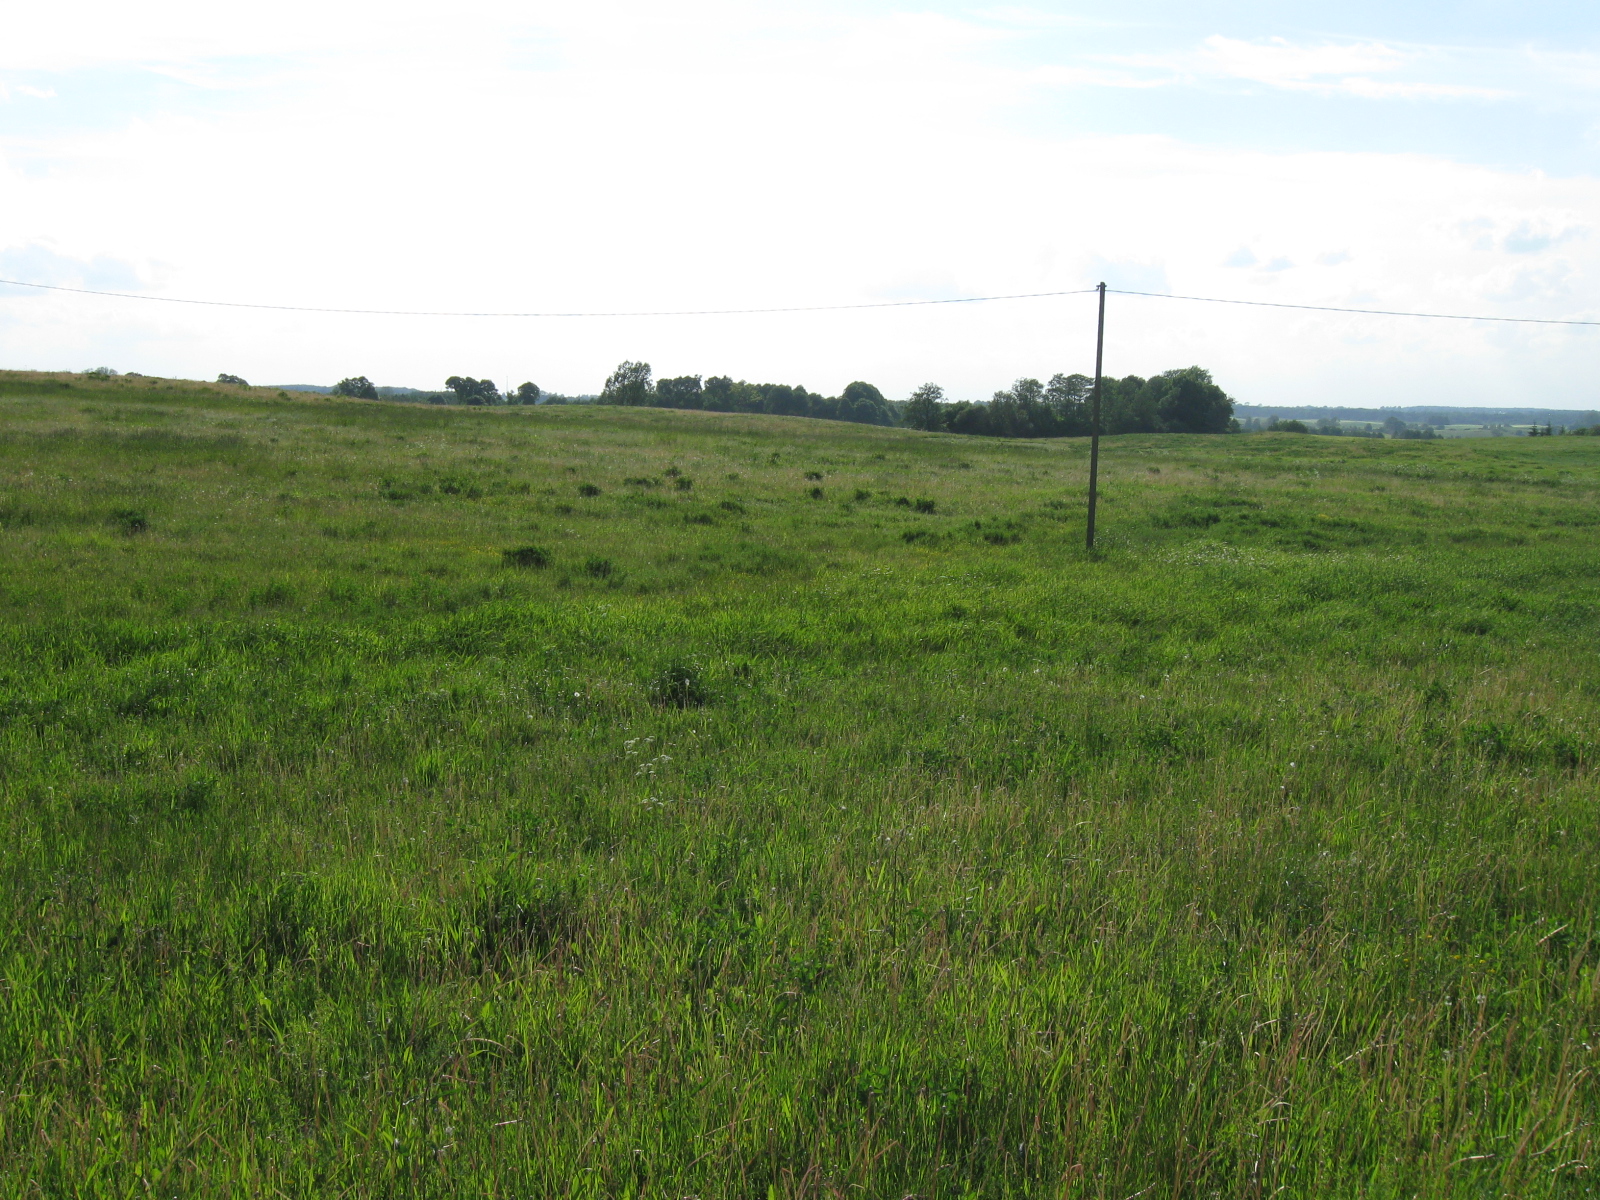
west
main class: Grassland
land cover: Grassland without tree/shrub cover
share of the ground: > 75 %
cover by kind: herbaceous plants 100 %
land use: Agriculture (excluding fallow land and kitchen gardens)
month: June
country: LT
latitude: 54.2398
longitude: 23.7278
